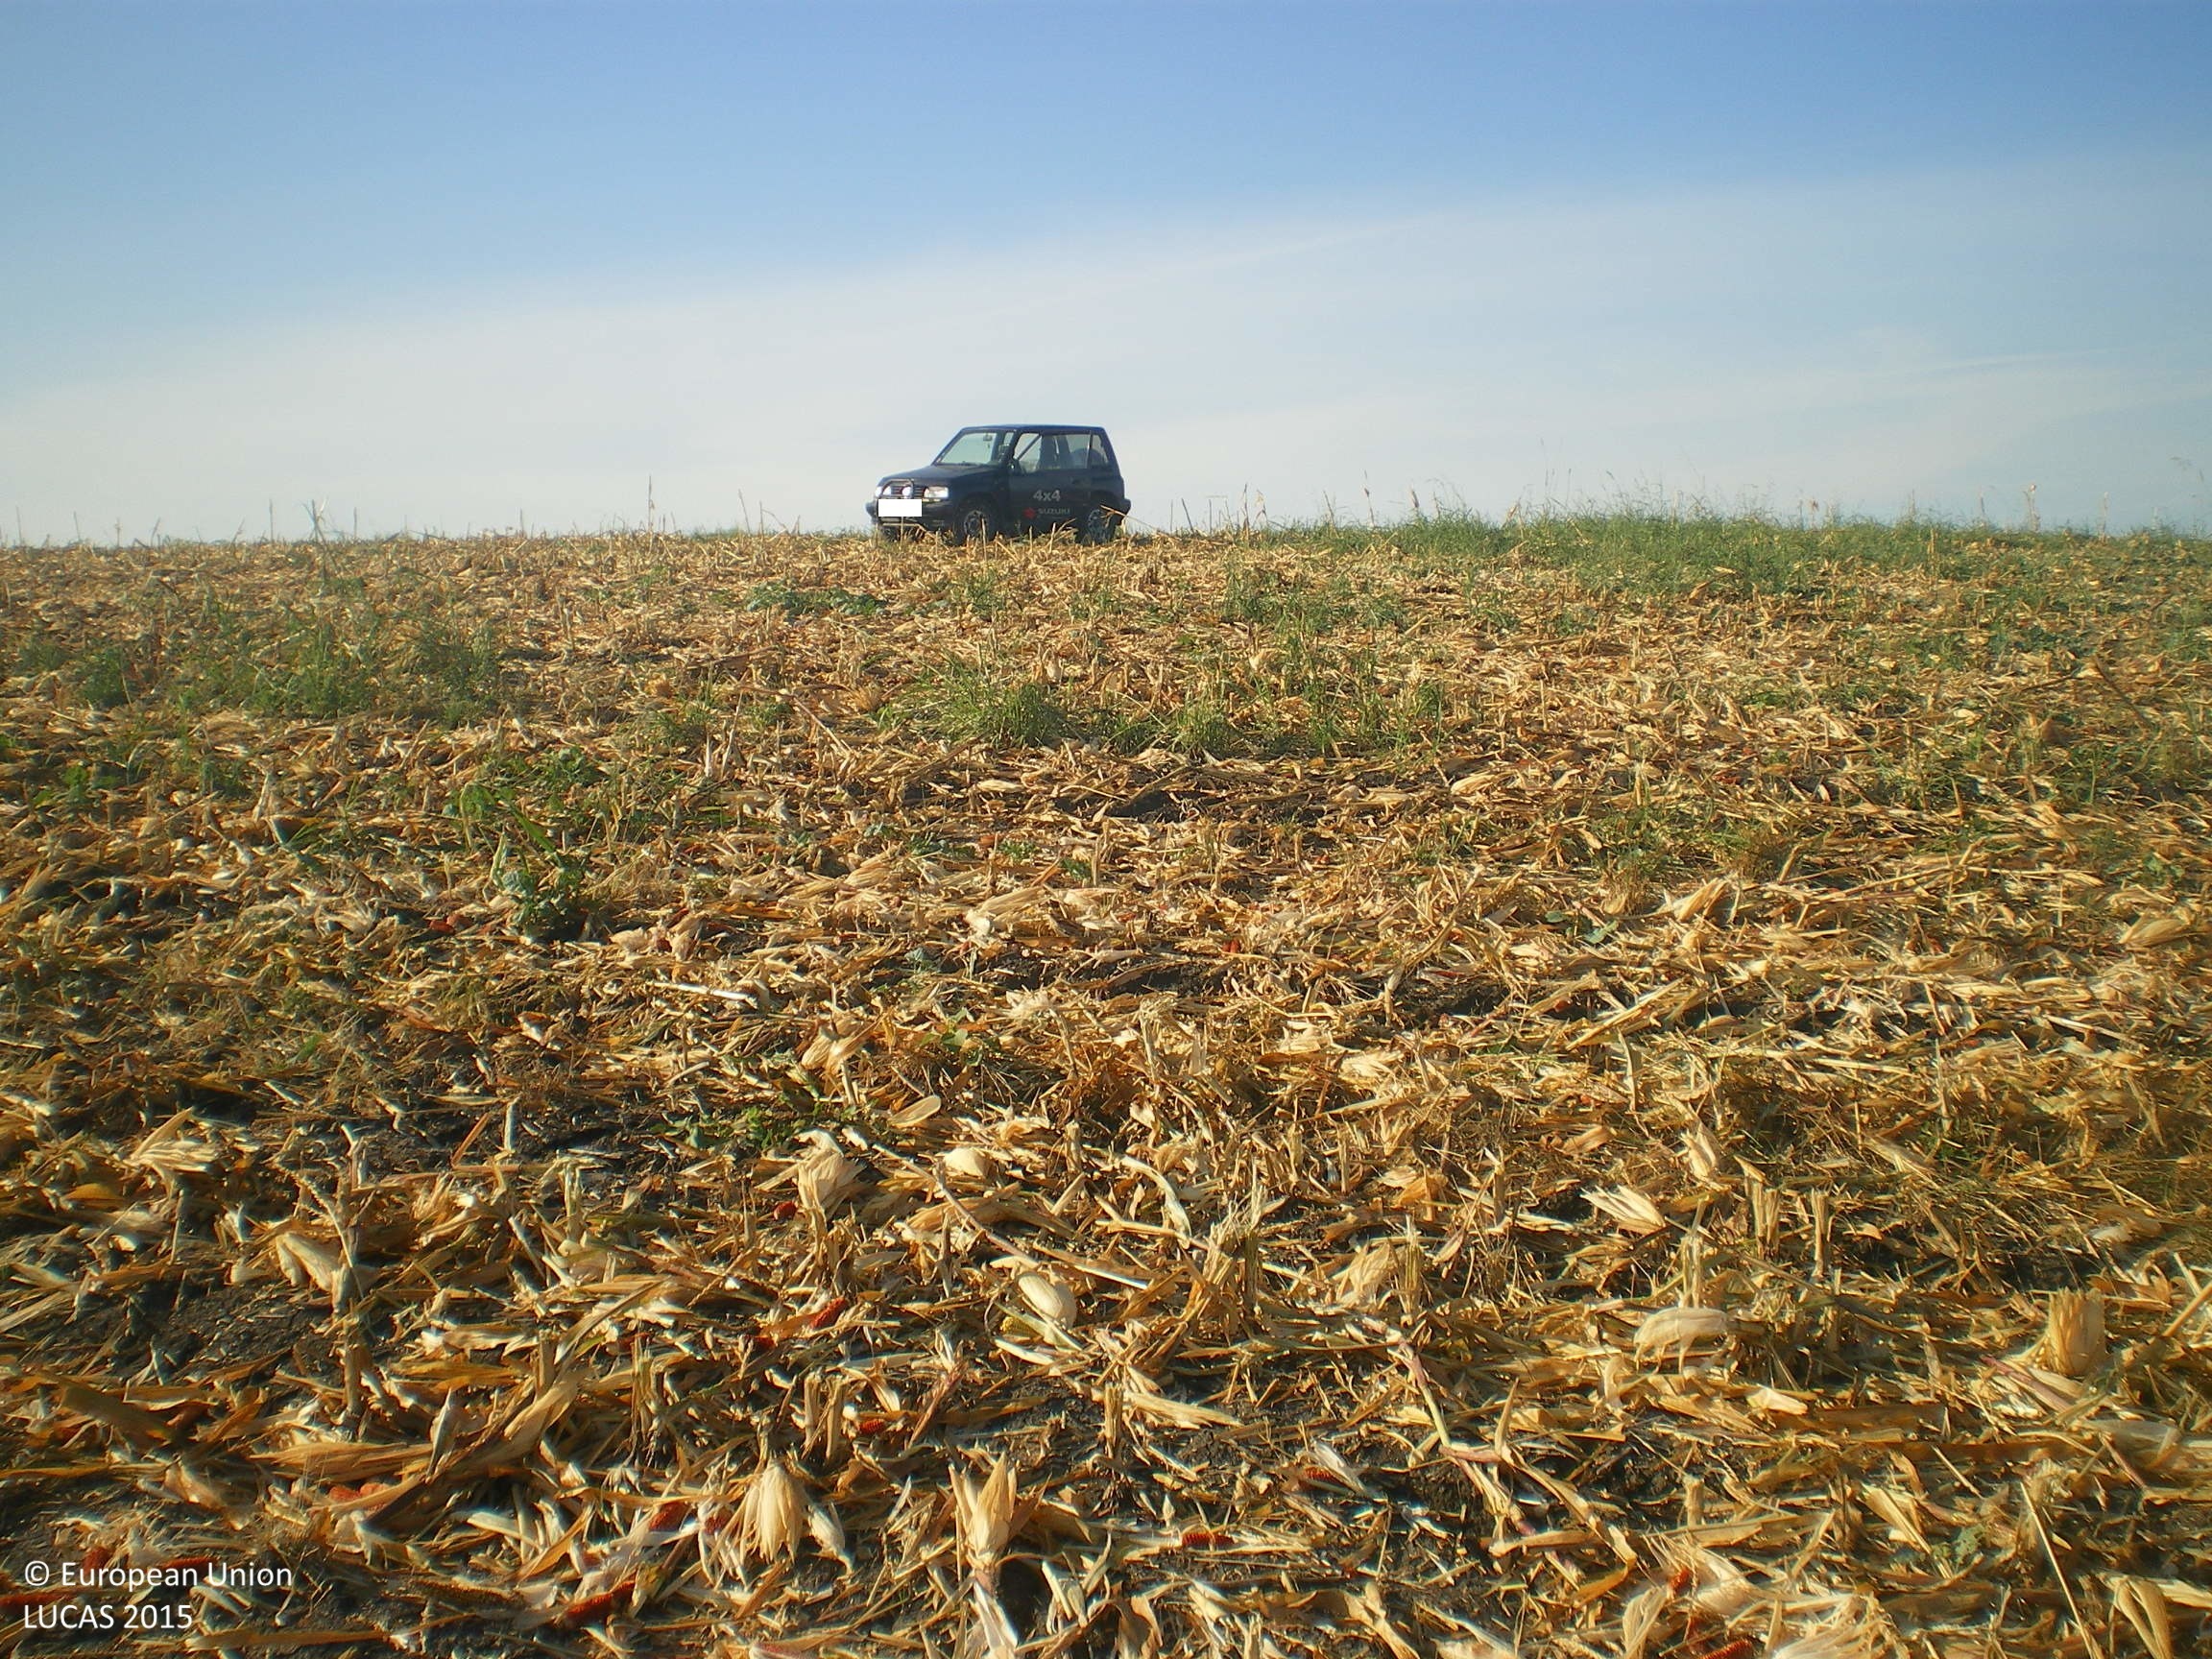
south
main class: Cropland
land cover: Maize
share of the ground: 10 - 25 %
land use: Agriculture (excluding fallow land and kitchen gardens)
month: September
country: BG
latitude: 42.0770
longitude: 25.8462
